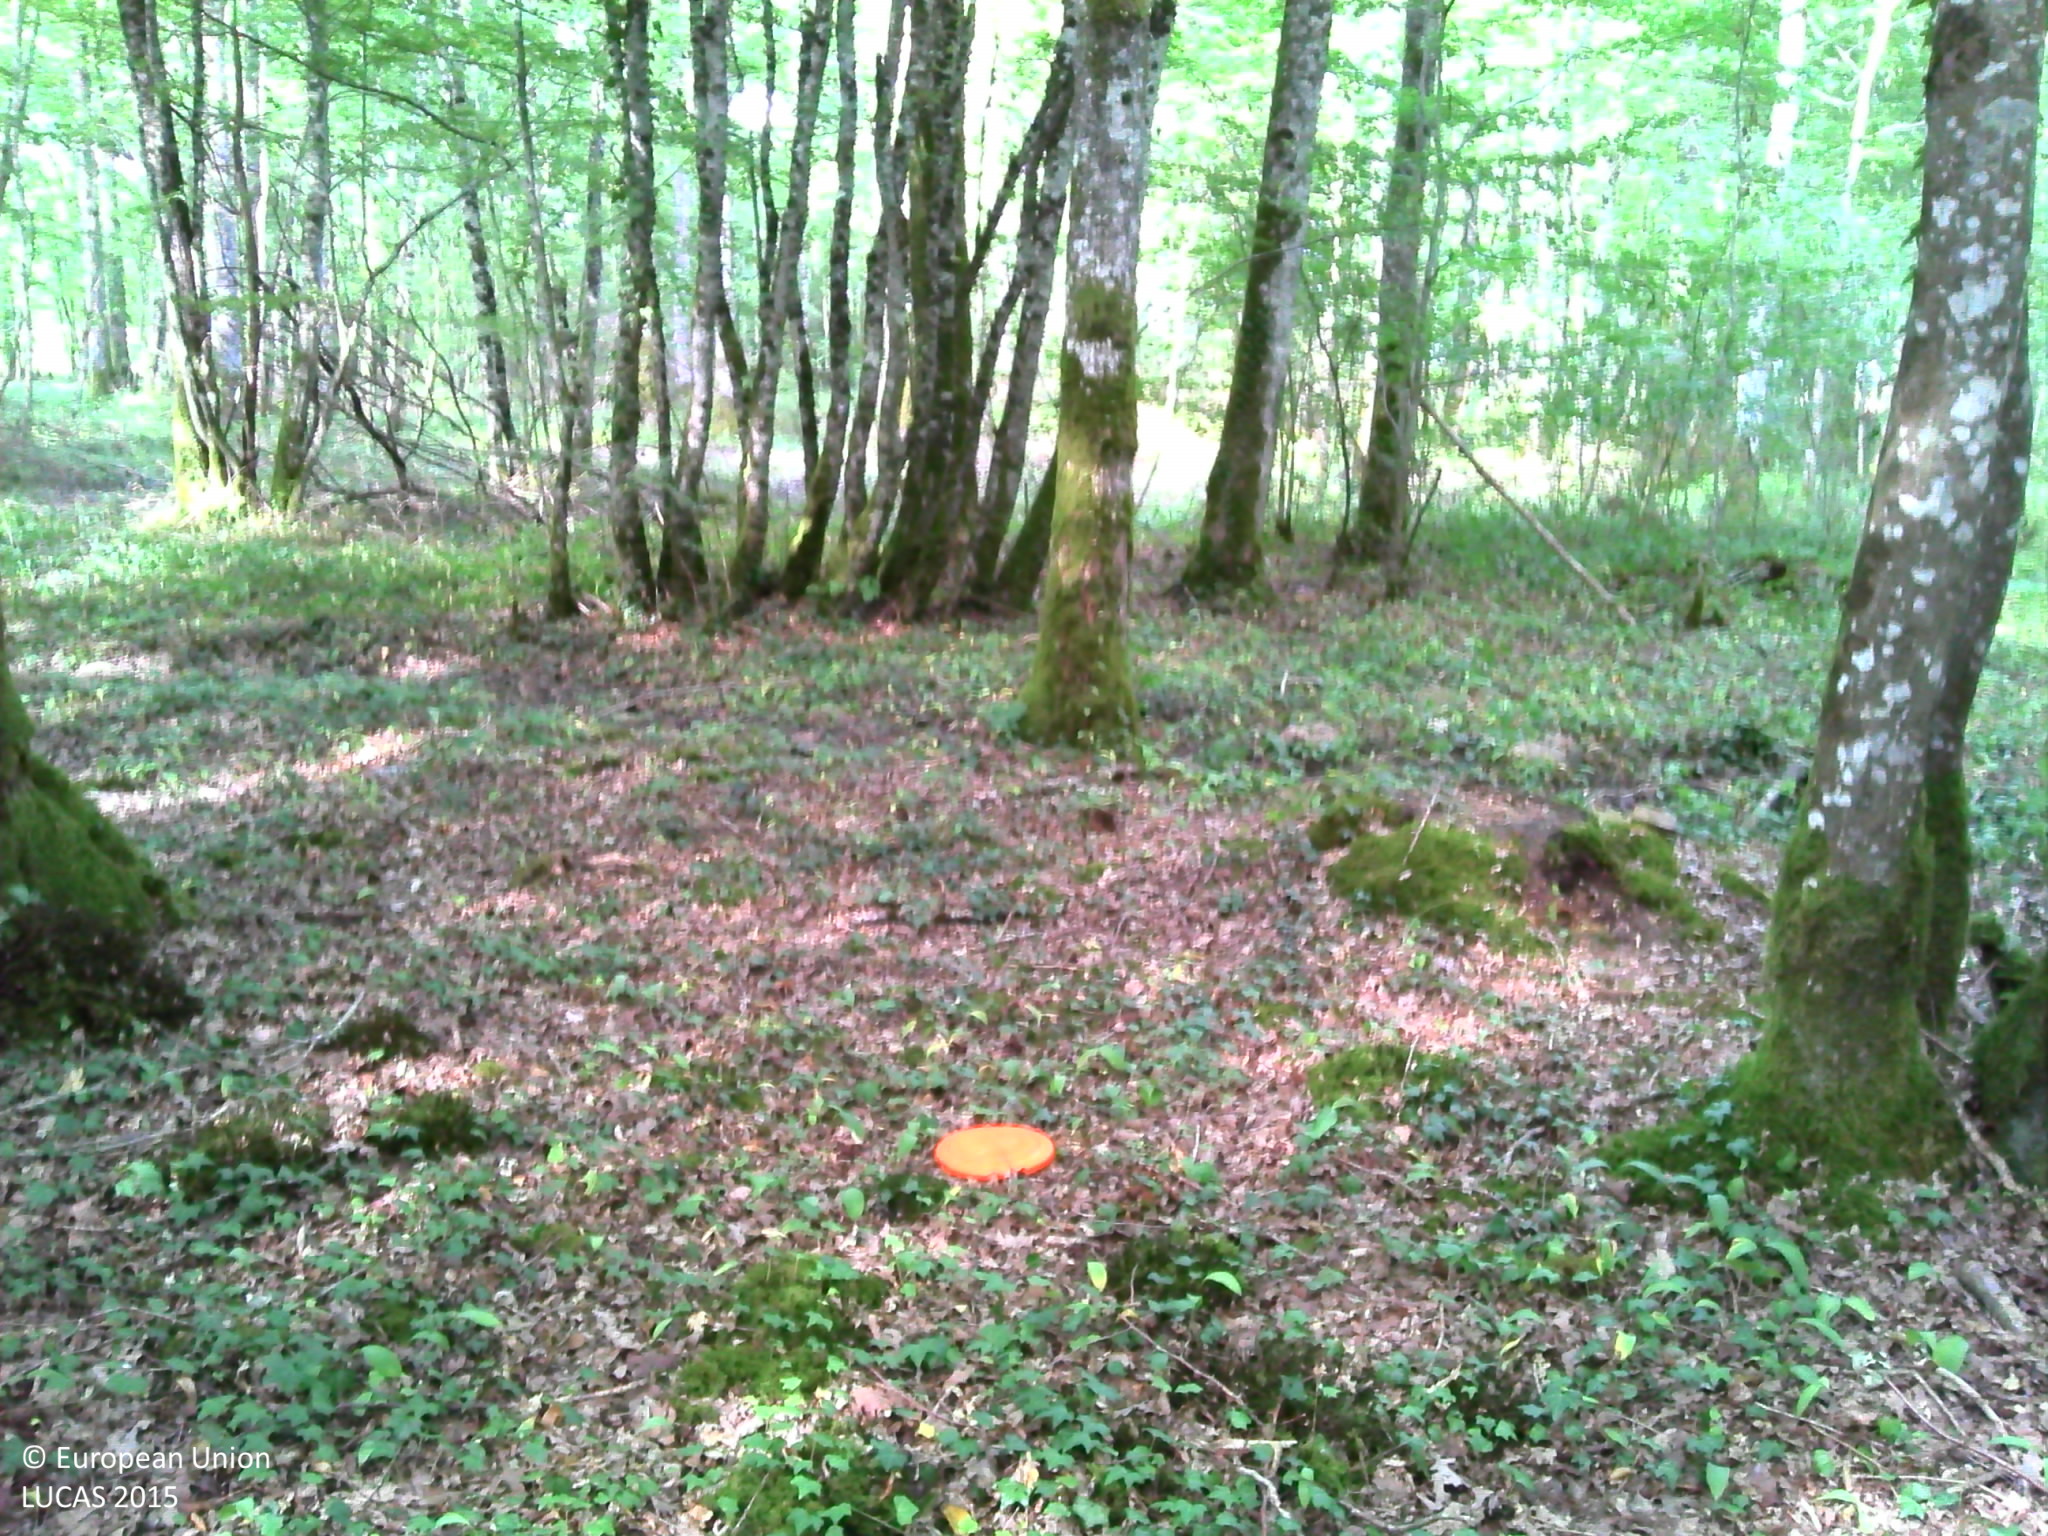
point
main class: Woodland
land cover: Broadleaved woodland
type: mesophytic deciduous forest
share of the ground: > 75 %
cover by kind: broadleaved forest trees 90 %, herbaceous plants 5 %, lichens and mosses 5 %
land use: Forestry
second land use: Amenities, museums, leisure
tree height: > 5 m
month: August
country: FR
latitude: 47.7168
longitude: 3.0757
